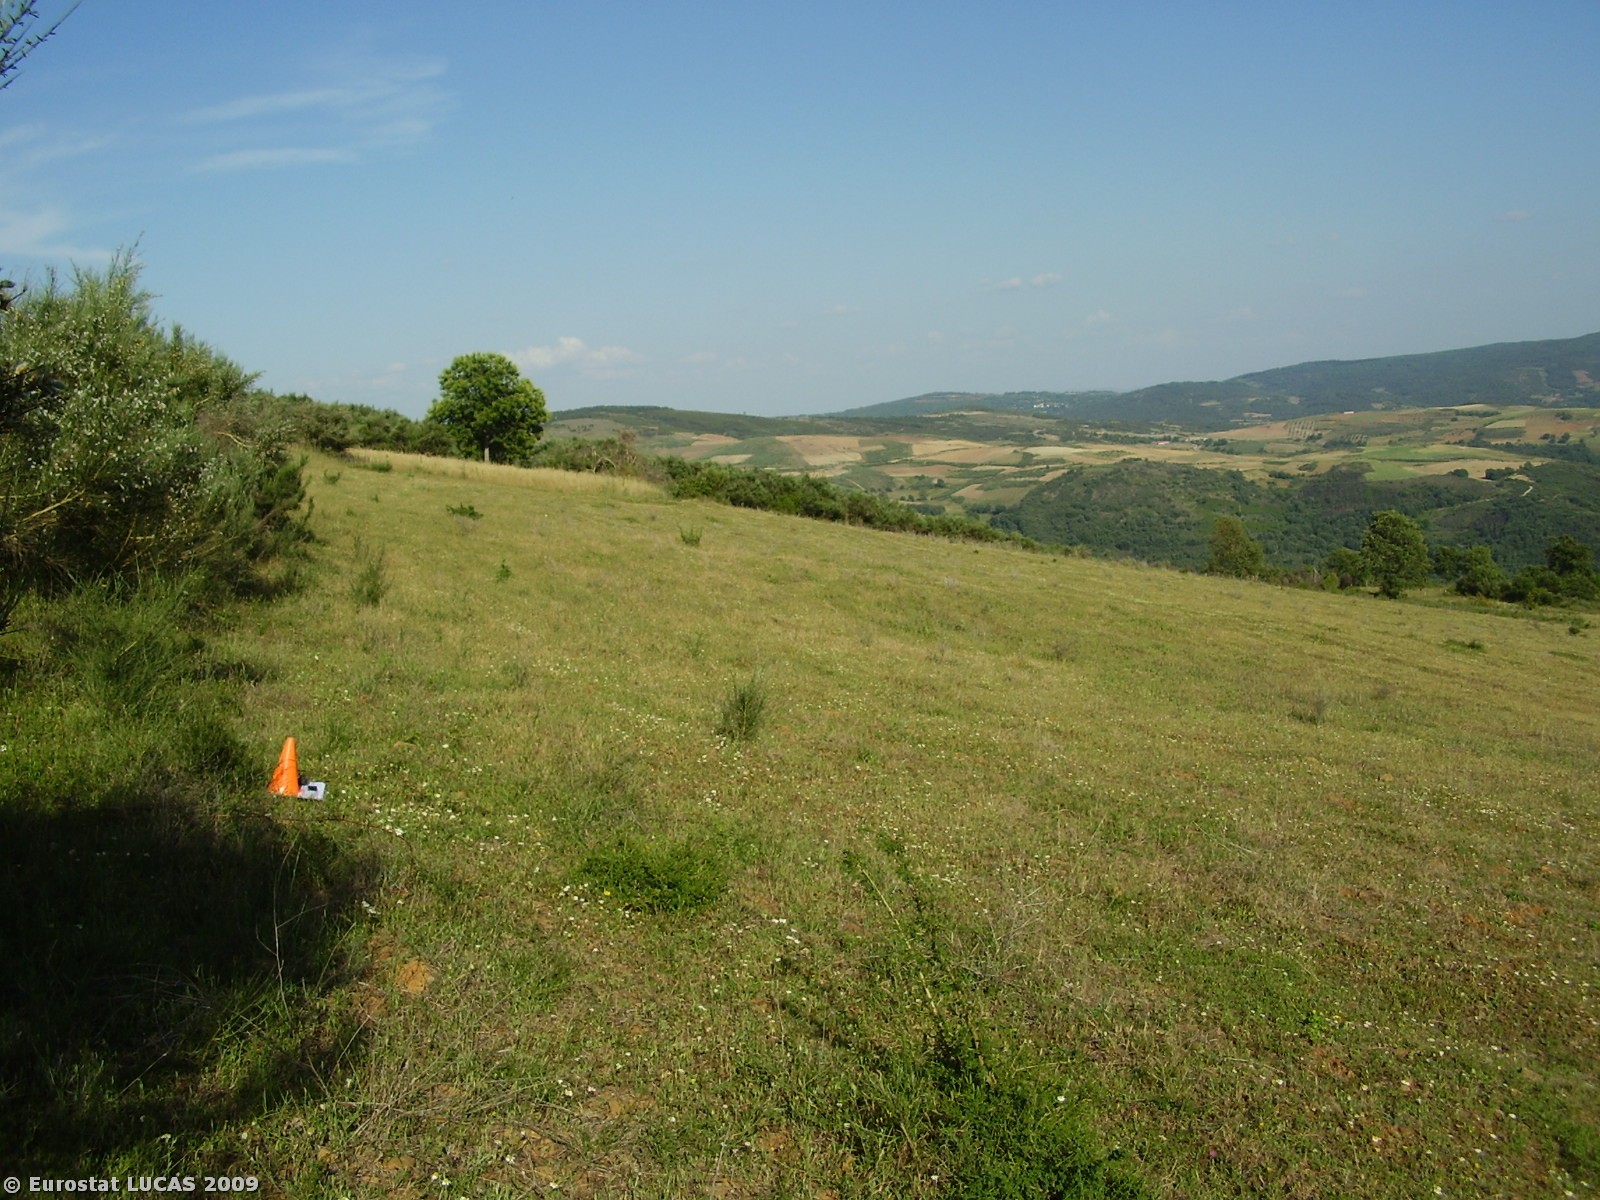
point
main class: Shrubland
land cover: Shrubland without tree cover
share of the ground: > 75 %
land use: Nature reserves
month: June
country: PT
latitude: 41.8757
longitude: -6.9519
